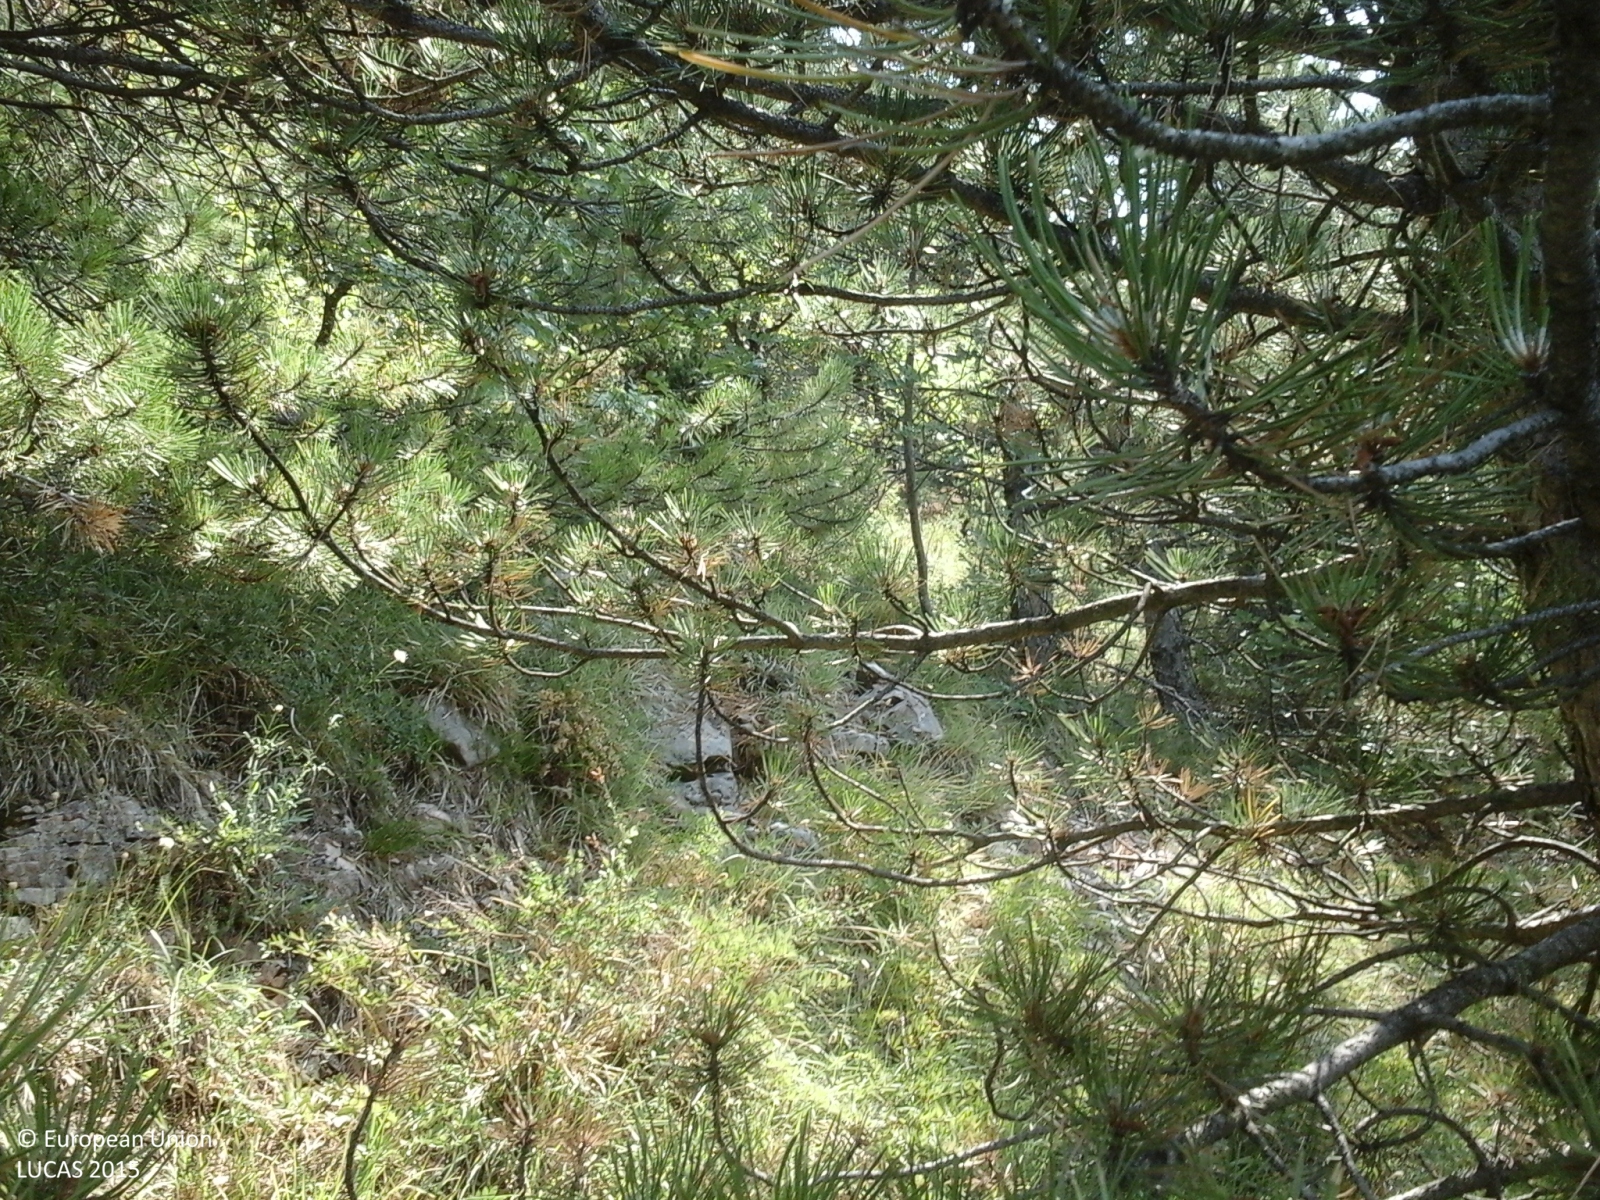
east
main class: Woodland
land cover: Other mixed woodland
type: thermophilous deciduous forest
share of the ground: > 75 %
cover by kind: broadleaved forest trees 75 %, coniferous forest trees 25 %
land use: Forestry
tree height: < 5 m
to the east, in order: Other mixed woodland; Grassland without tree/shrub cover; Tracks; Grassland without tree/shrub cover
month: August
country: IT
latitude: 43.0216
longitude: 13.1203
